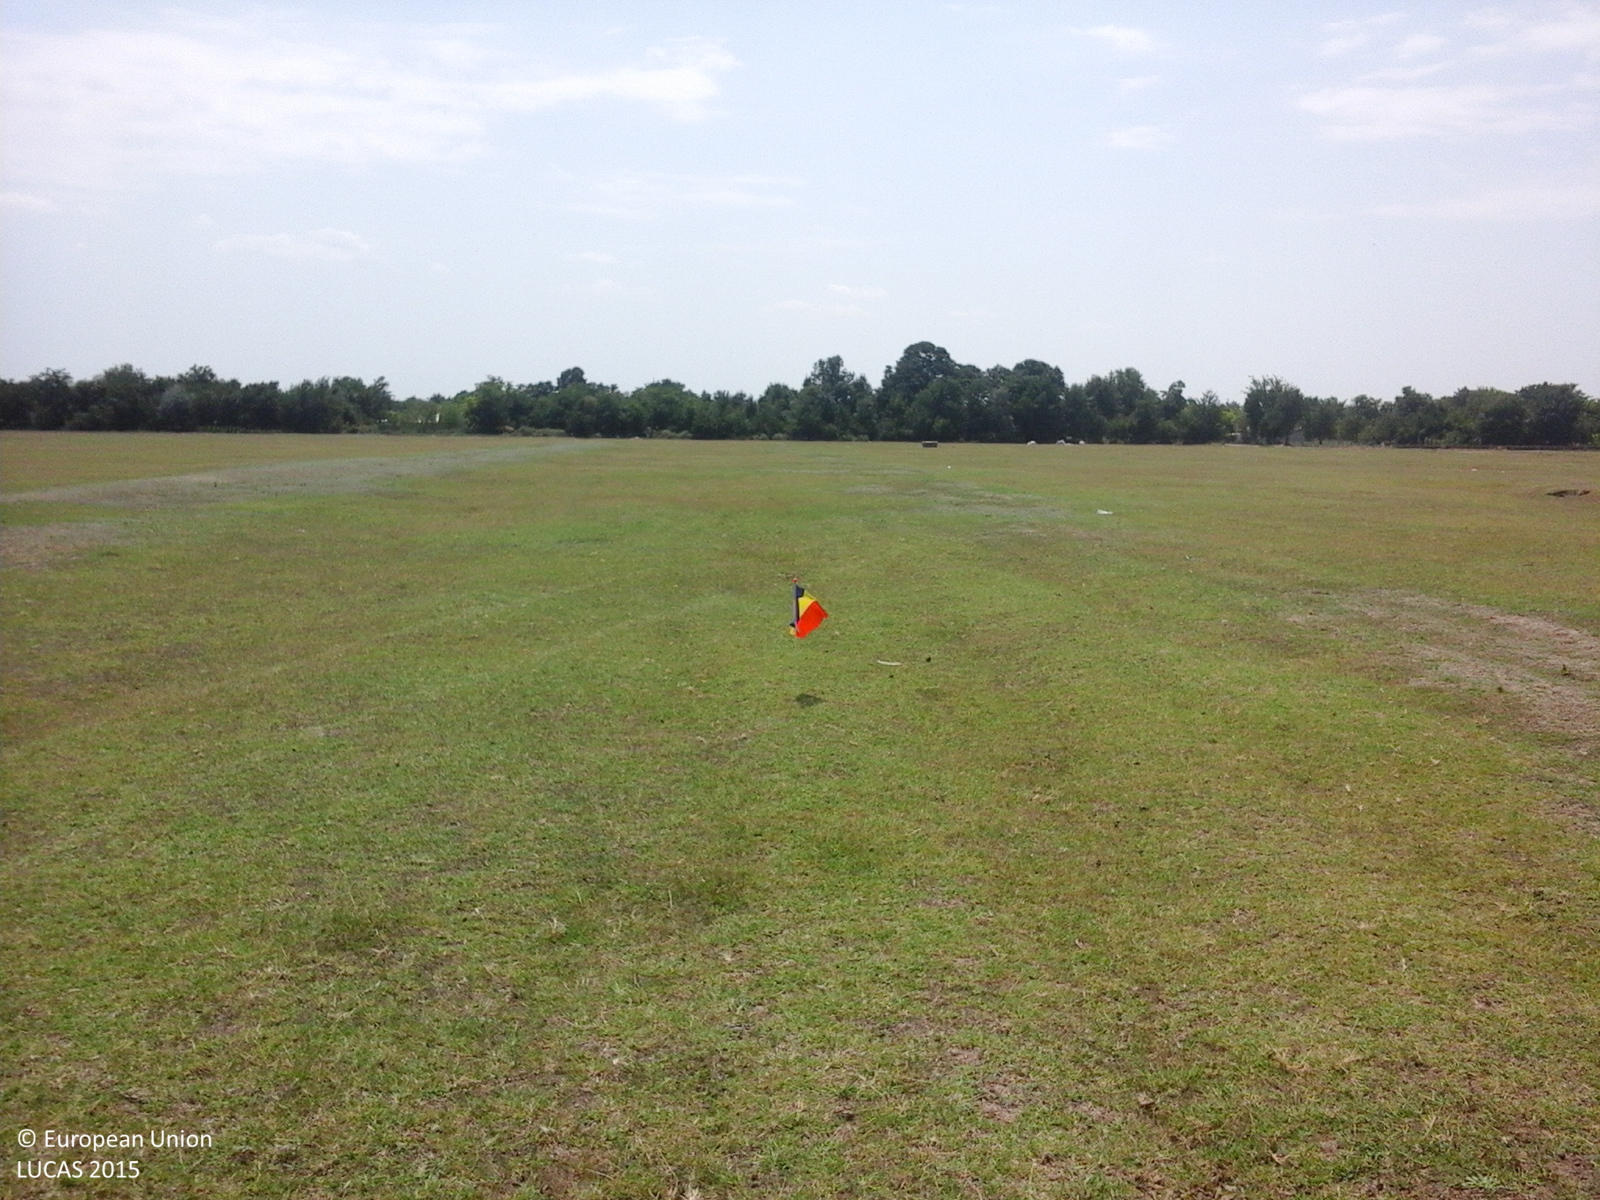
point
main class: Grassland
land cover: Grassland without tree/shrub cover
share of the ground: > 75 %
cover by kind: herbaceous plants 100 %
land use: Agriculture (excluding fallow land and kitchen gardens)
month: July
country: RO
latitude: 44.4440
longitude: 27.5461
